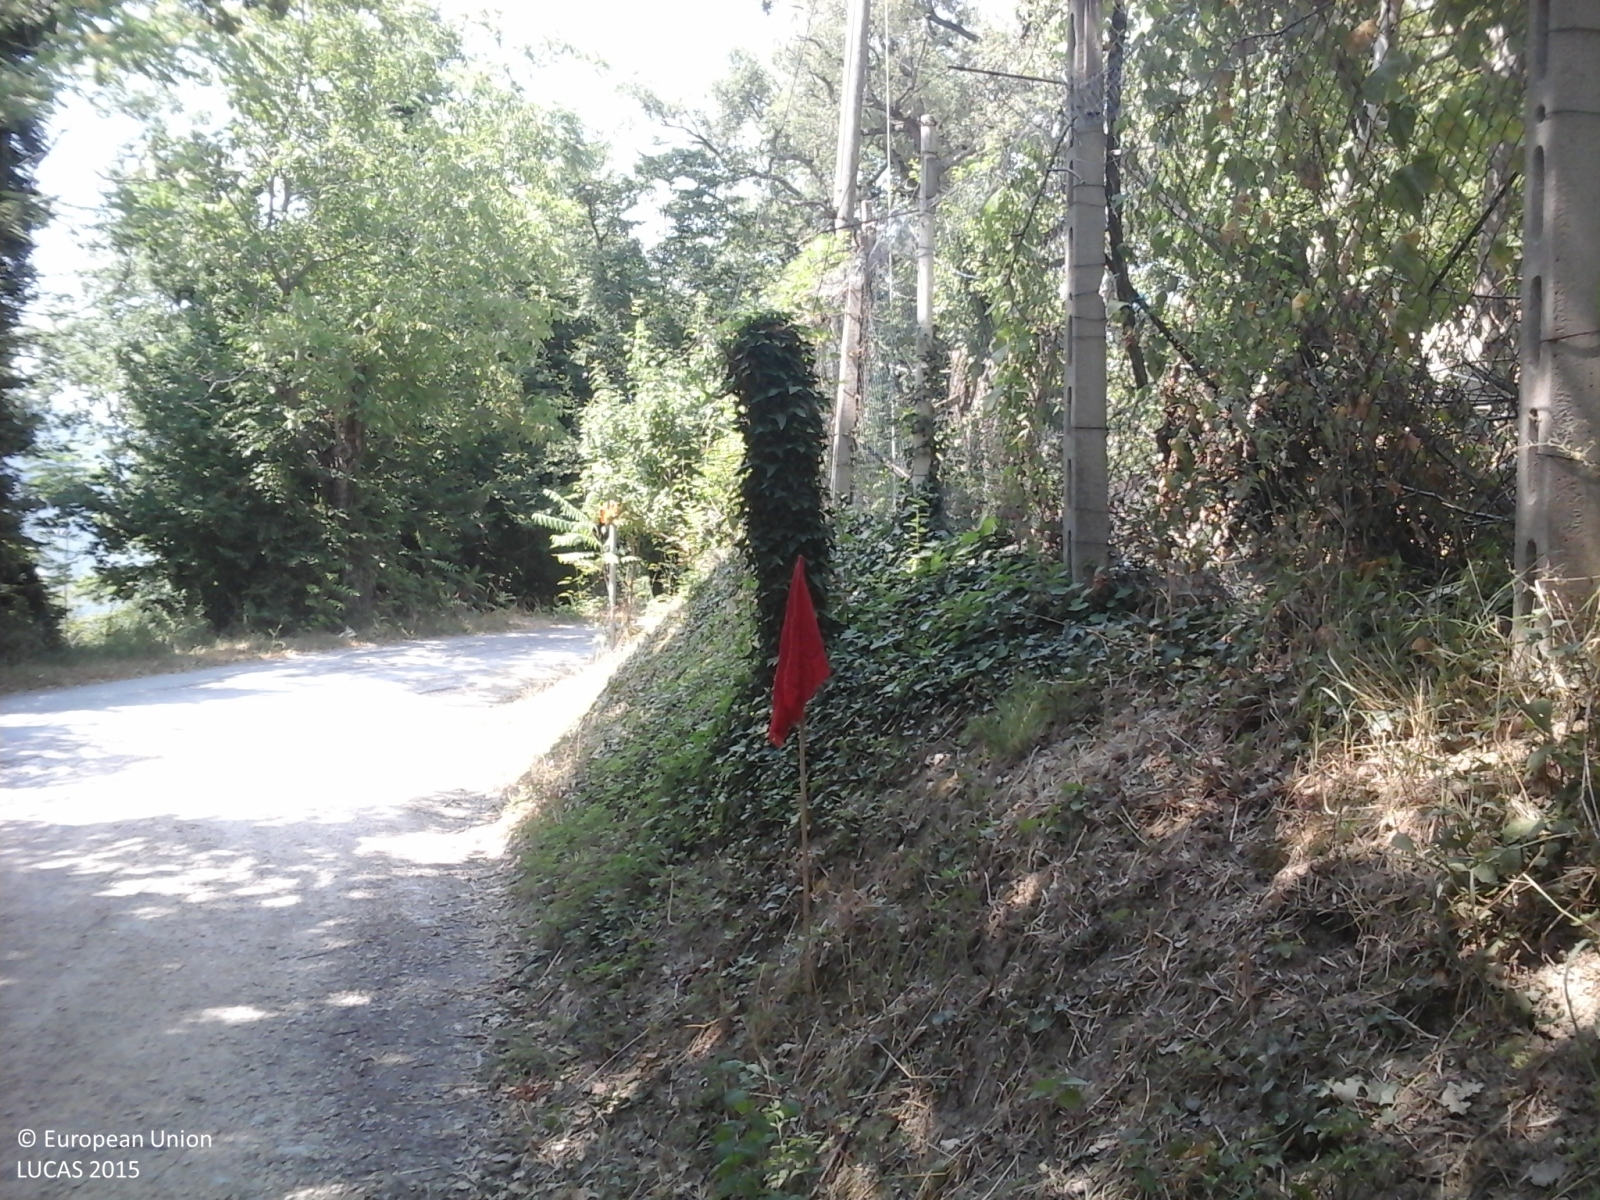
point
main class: Cropland
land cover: Nuts trees
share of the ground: > 75 %
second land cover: Other bare soil
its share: > 75 %
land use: Kitchen garden
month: July
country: IT
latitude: 42.9736
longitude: 13.4849
